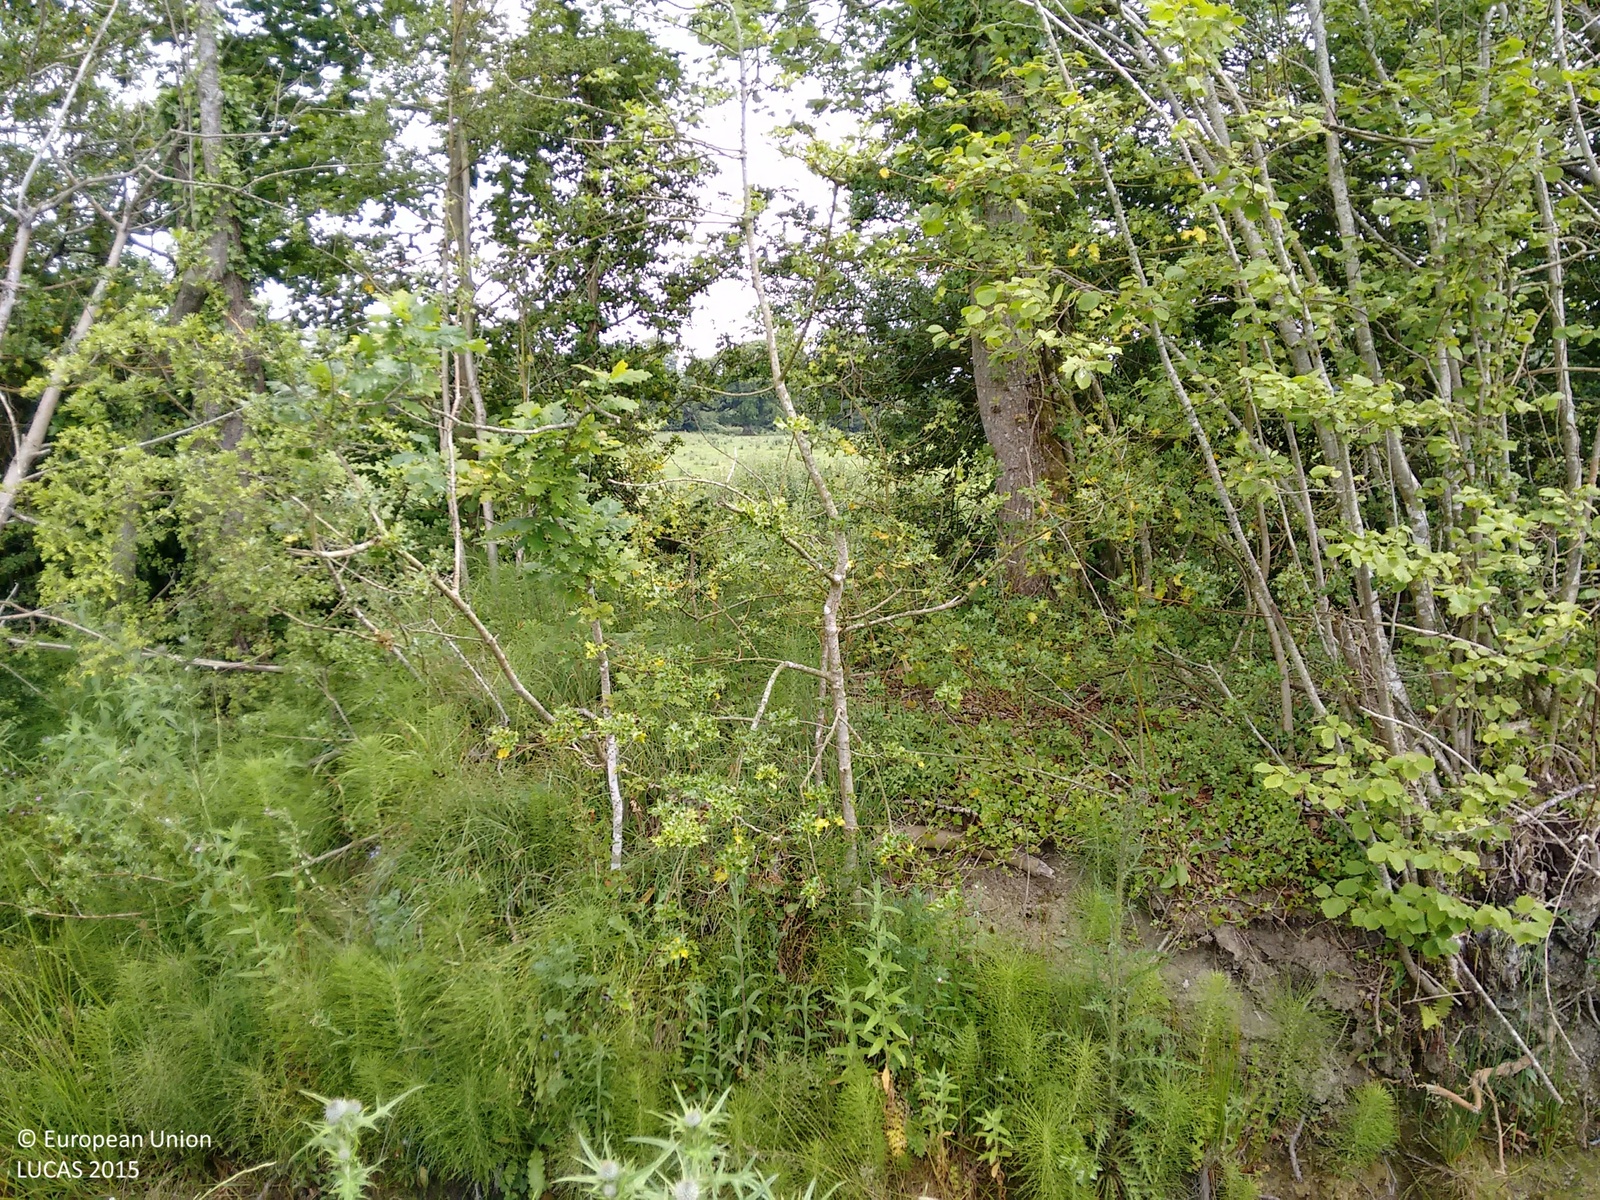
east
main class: Grassland
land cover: Grassland without tree/shrub cover
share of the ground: > 75 %
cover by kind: herbaceous plants 100 %
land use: Agriculture (excluding fallow land and kitchen gardens)
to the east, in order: Grassland without tree/shrub cover; Grassland with sparse tree/shrub cover
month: July
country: IE
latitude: 52.4912
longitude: -7.4325
